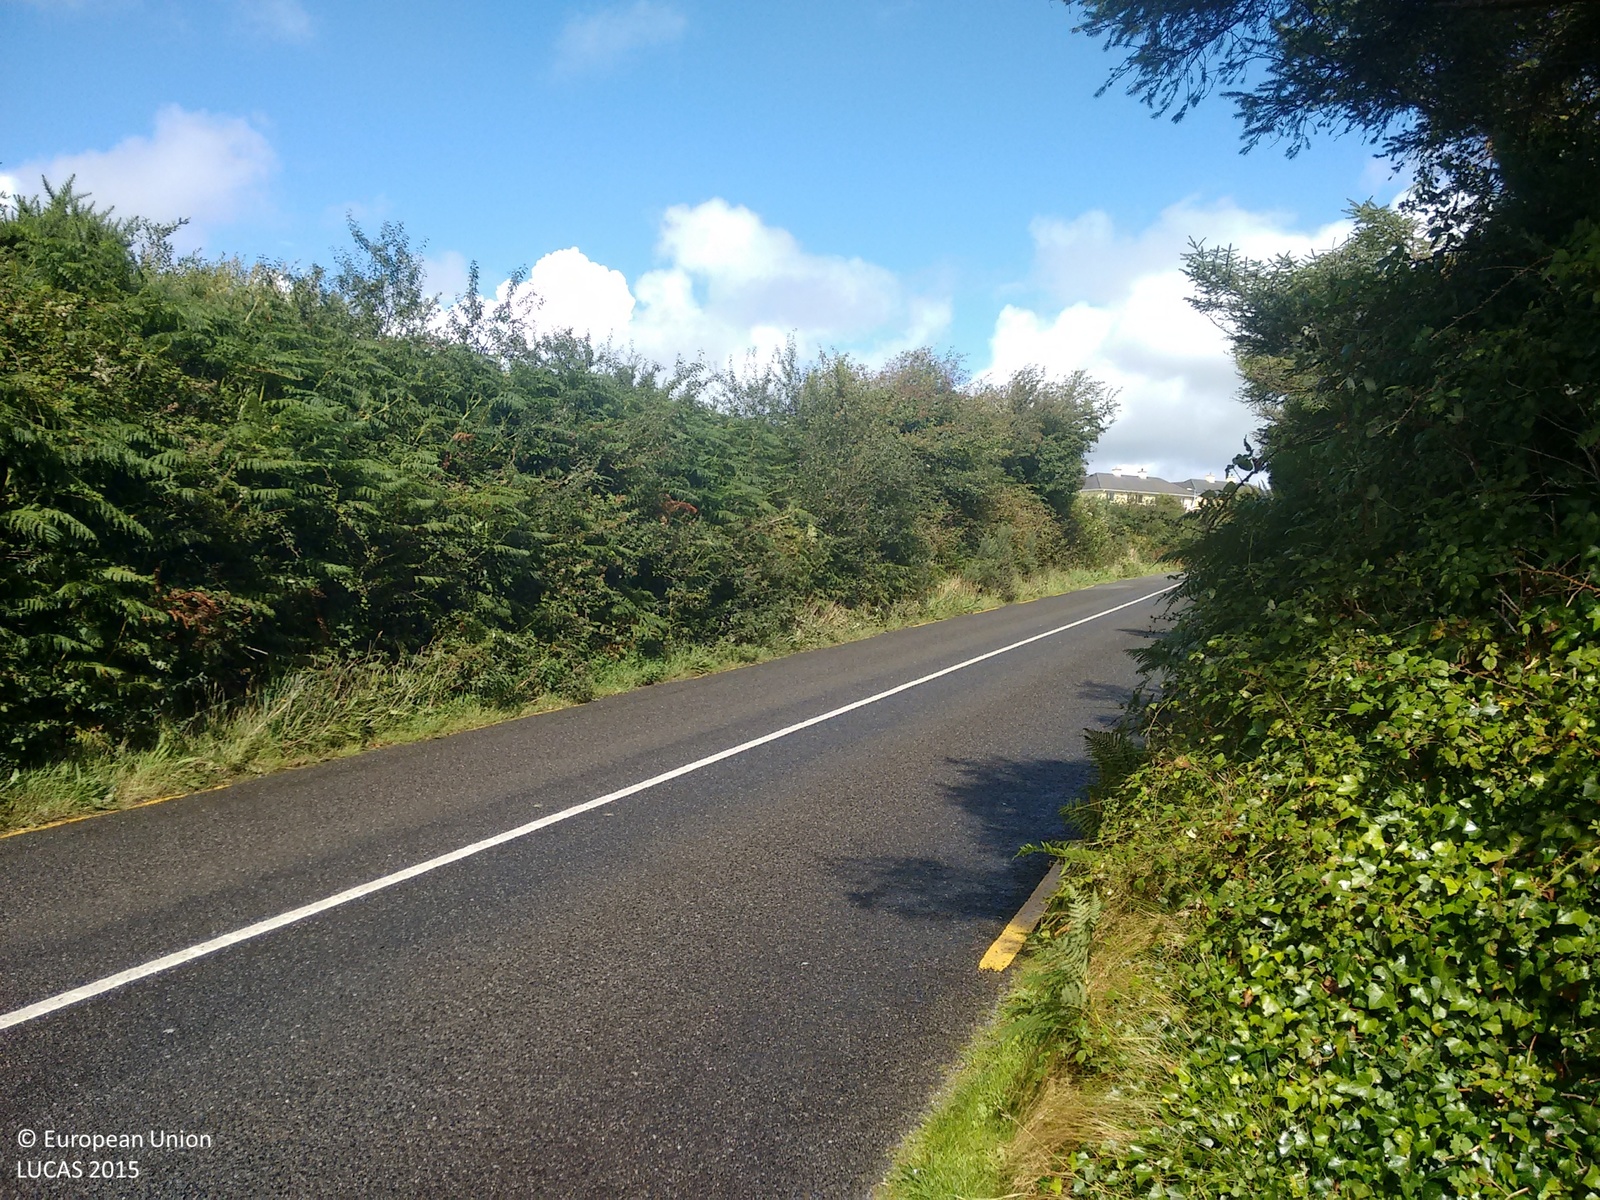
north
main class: Grassland
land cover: Grassland without tree/shrub cover
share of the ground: > 75 %
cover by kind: herbaceous plants 70 %, consolidated bare surface 25 %, shrubs 5 %
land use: Residential
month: August
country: IE
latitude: 52.0955
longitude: -9.7904
